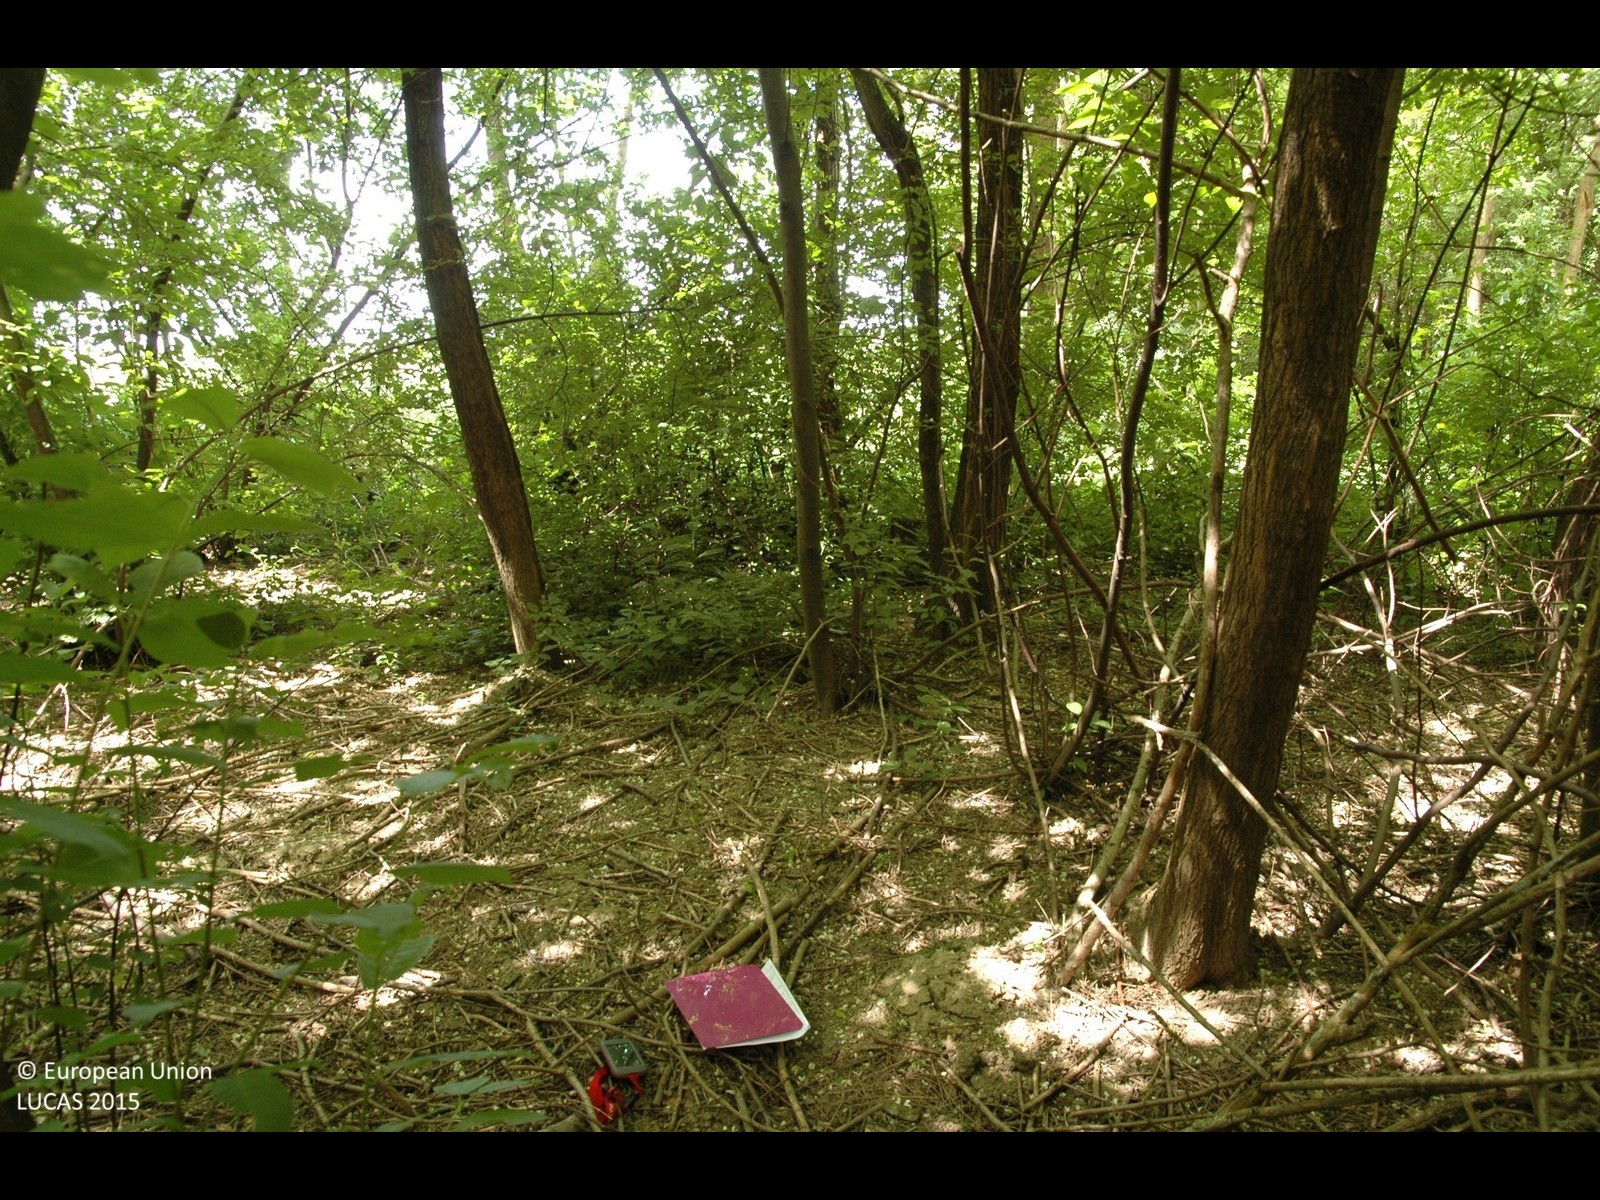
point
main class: Woodland
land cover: Broadleaved woodland
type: floodplain forest
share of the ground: > 75 %
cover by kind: broadleaved forest trees 90 %, shrubs 5 %, herbaceous plants 5 %
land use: Forestry
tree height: > 5 m
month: May
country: HR
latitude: 46.3024
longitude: 16.4271
